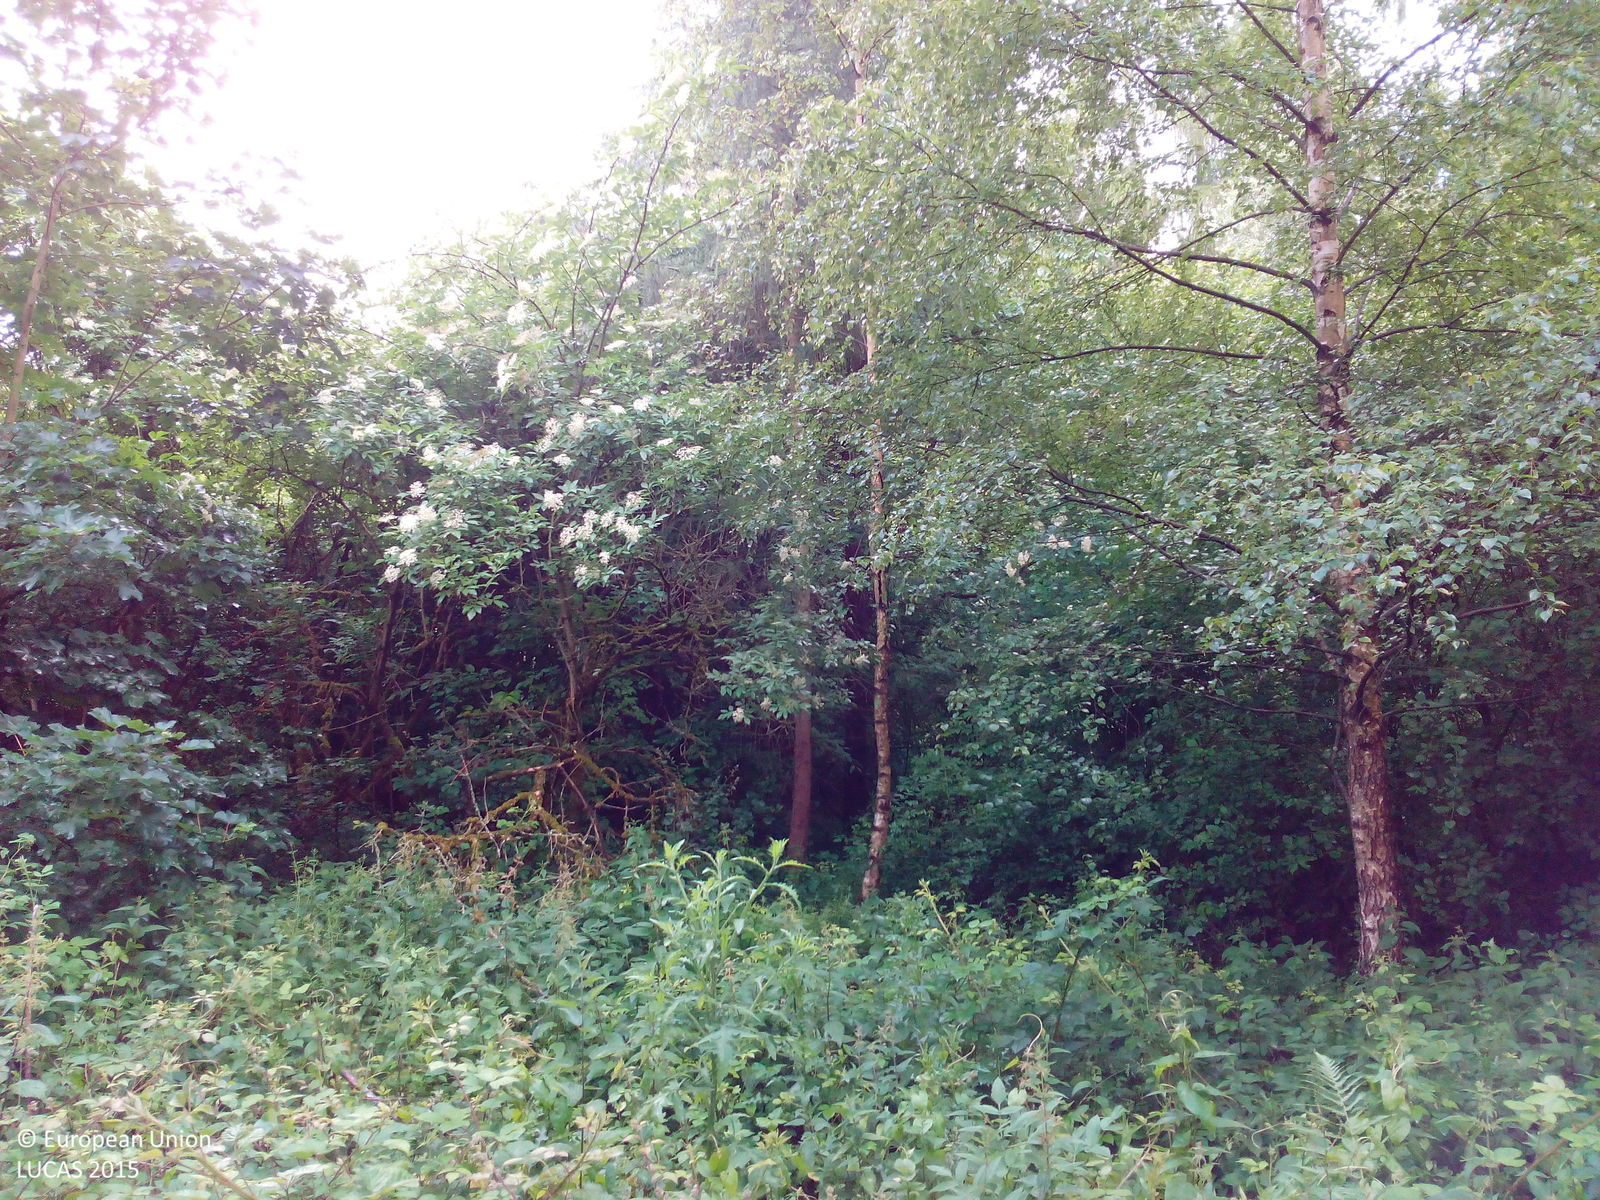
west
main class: Woodland
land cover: Spruce dominated coniferous woodland
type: hemiboreal forest and nemoral coniferous forest and mixed broadleaved-coniferous forest
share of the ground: > 75 %
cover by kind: coniferous forest trees 90 %, broadleaved forest trees 10 %
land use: Forestry
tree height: > 5 m
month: June
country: DE
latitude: 51.9100
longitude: 9.8692
